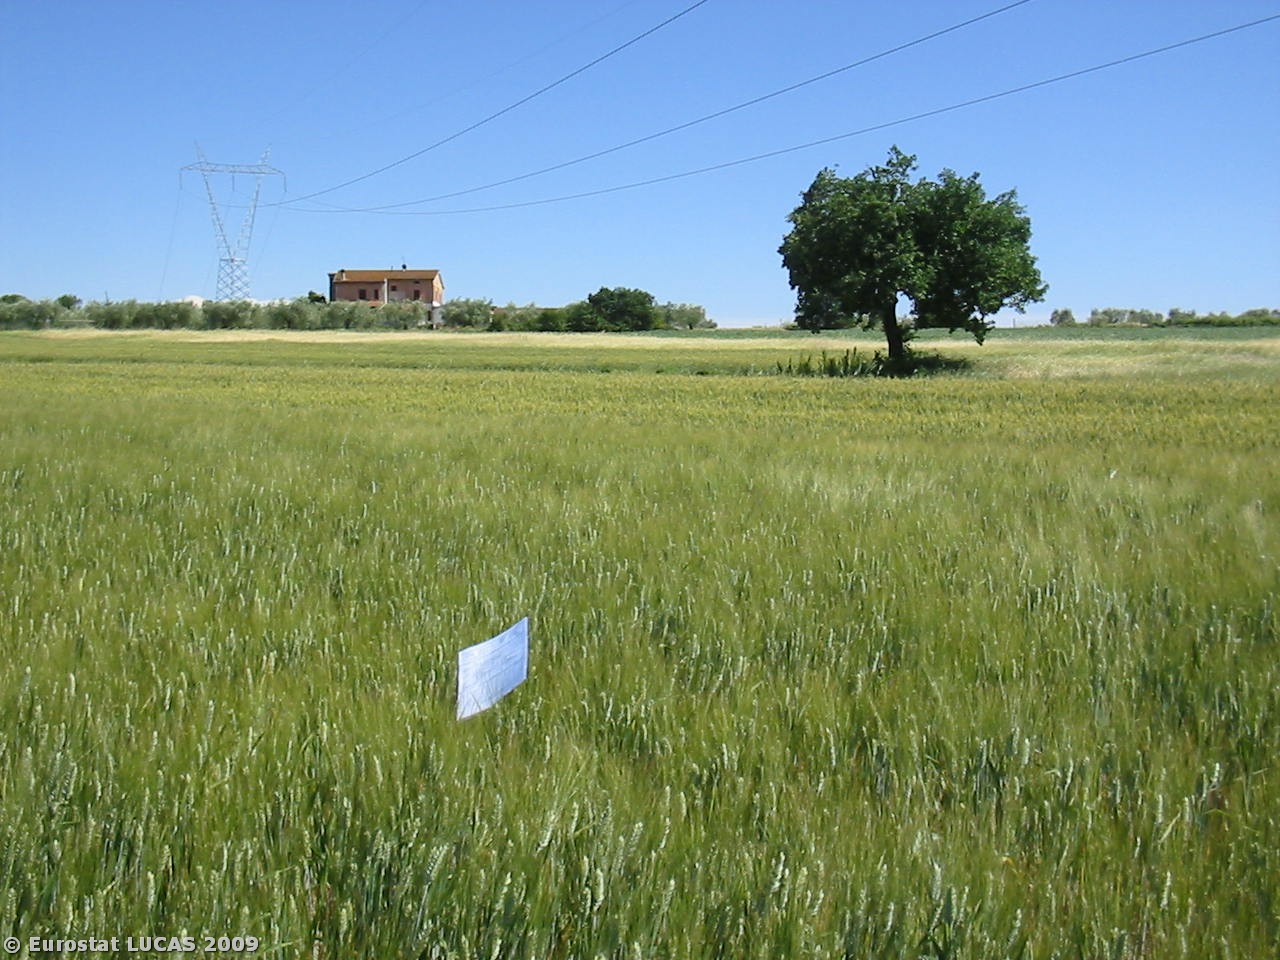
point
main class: Cropland
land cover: Durum wheat
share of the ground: > 75 %
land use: Agriculture (excluding fallow land and kitchen gardens)
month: May
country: IT
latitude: 43.0849
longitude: 12.0453
